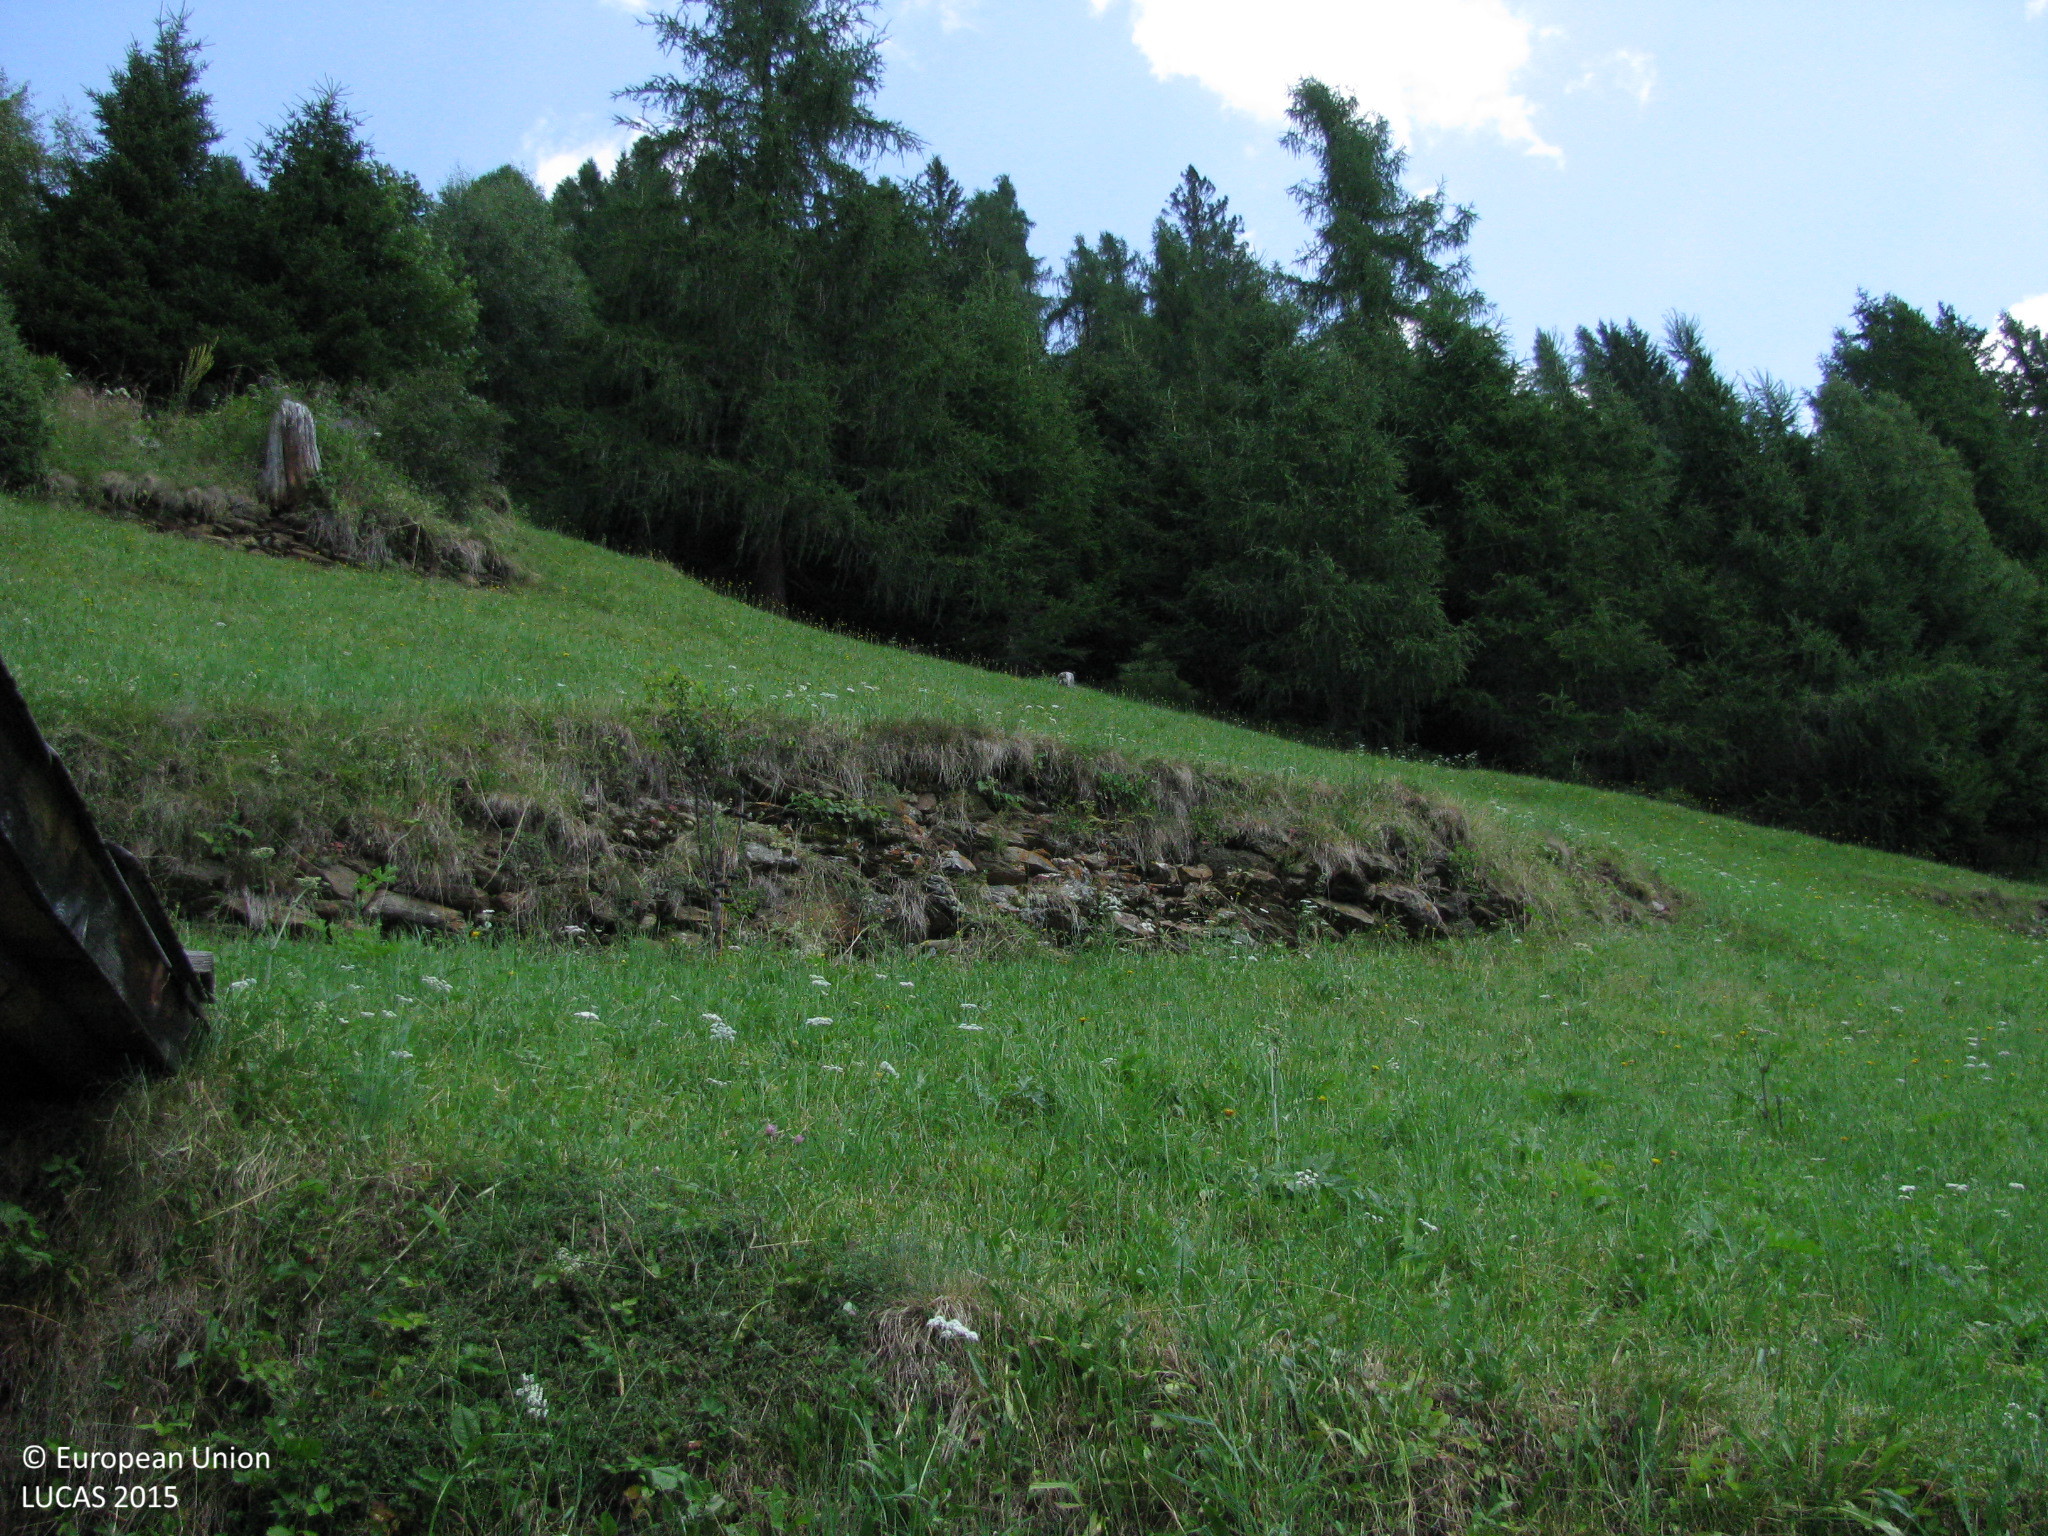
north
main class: Grassland
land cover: Grassland with sparse tree/shrub cover
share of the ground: > 75 %
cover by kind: herbaceous plants 95 %, broadleaved forest trees 5 %
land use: Agriculture (excluding fallow land and kitchen gardens)
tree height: < 5 m
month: July
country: AT
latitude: 46.8114
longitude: 12.3698
